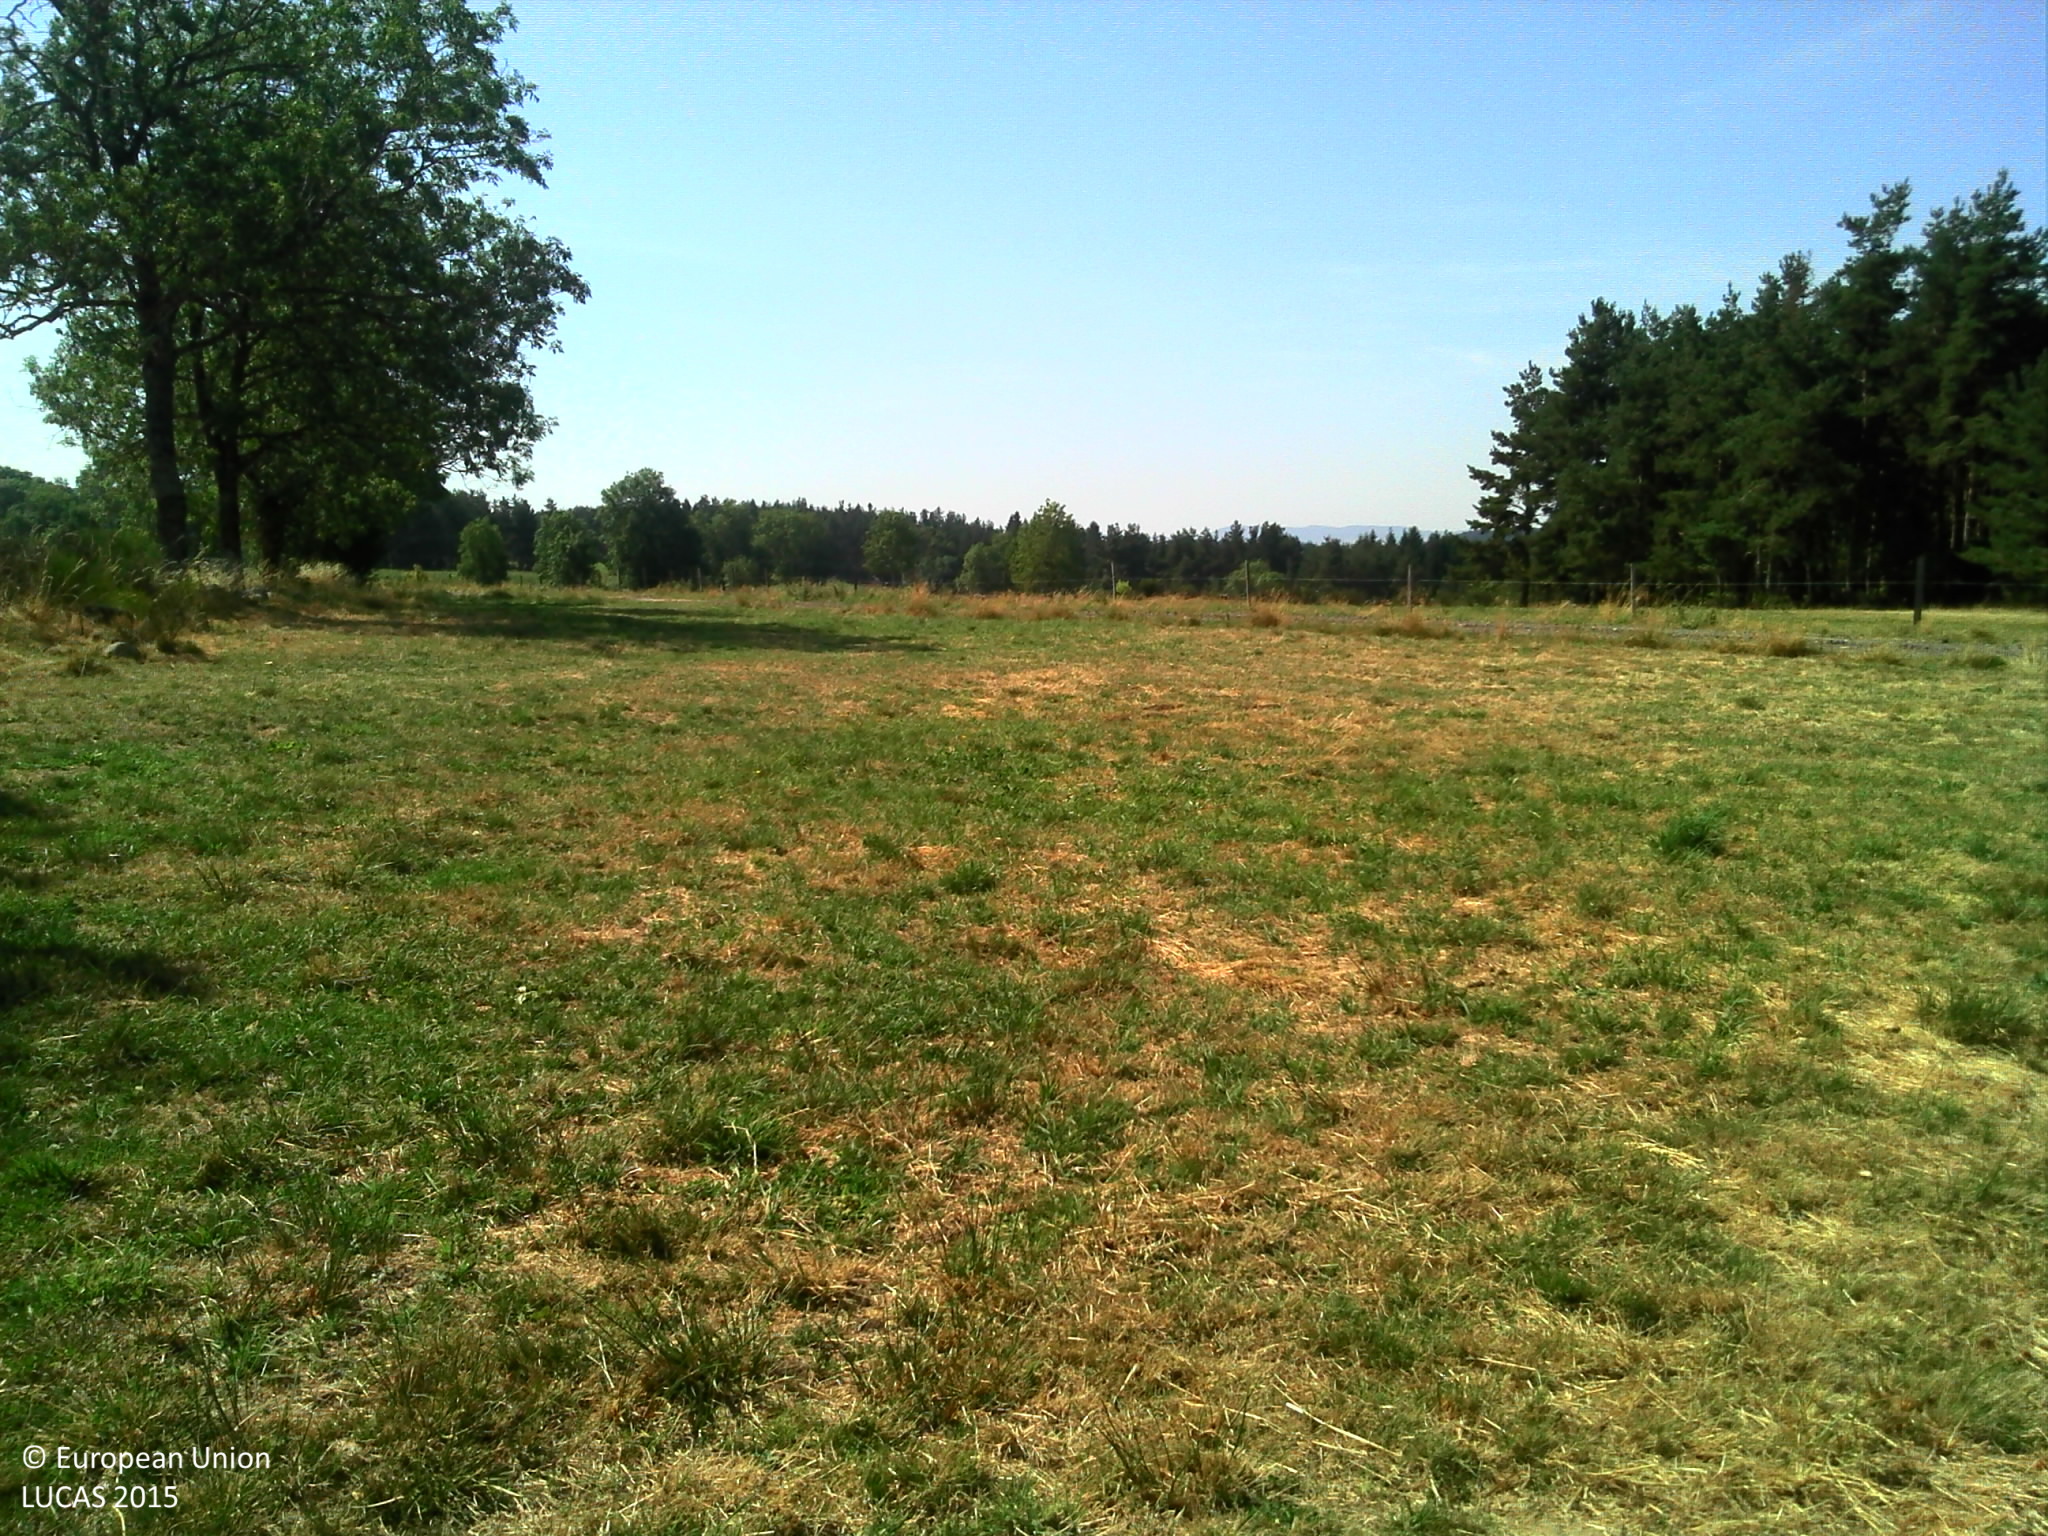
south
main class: Grassland
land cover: Grassland without tree/shrub cover
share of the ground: > 75 %
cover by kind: herbaceous plants 100 %
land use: Agriculture (excluding fallow land and kitchen gardens)
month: August
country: FR
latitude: 45.2139
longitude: 3.8023
